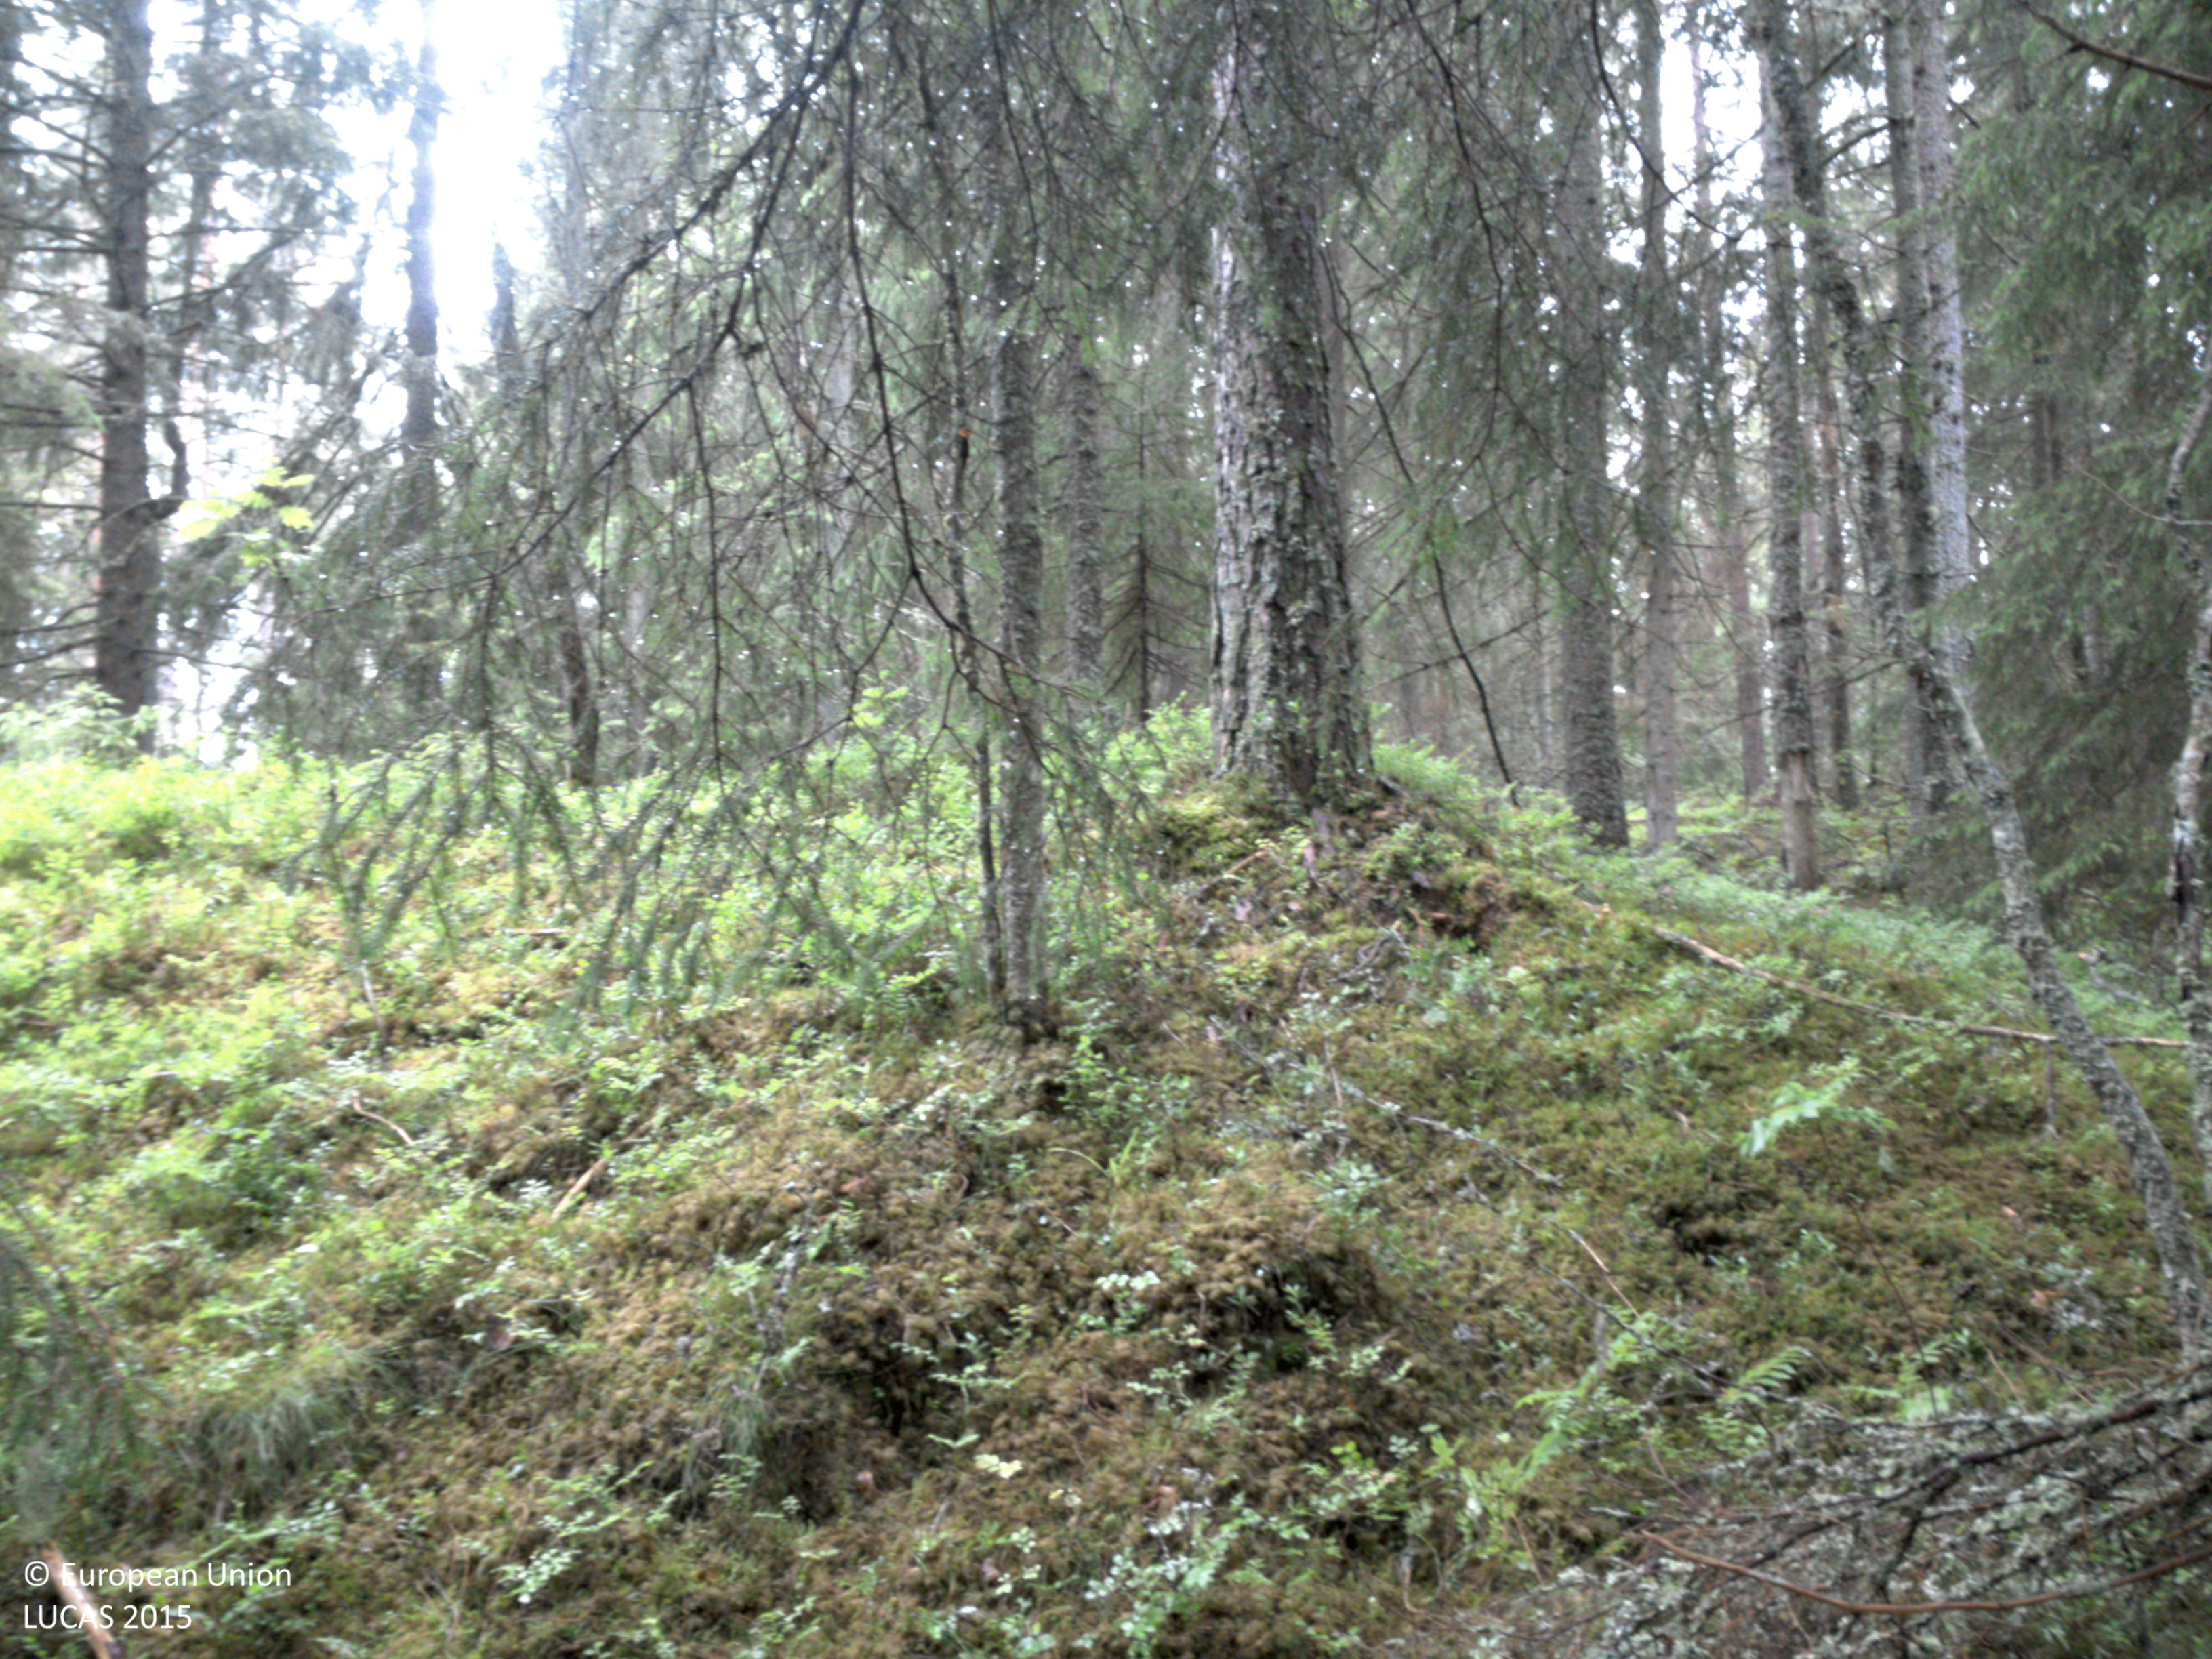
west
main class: Woodland
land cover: Spruce dominated coniferous woodland
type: boreal forest
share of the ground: 50 - 75 %
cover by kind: coniferous forest trees 65 %, lichens and mosses 20 %, herbaceous plants 15 %
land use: Forestry
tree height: > 5 m
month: July
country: SE
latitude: 58.6732
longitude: 11.9444
